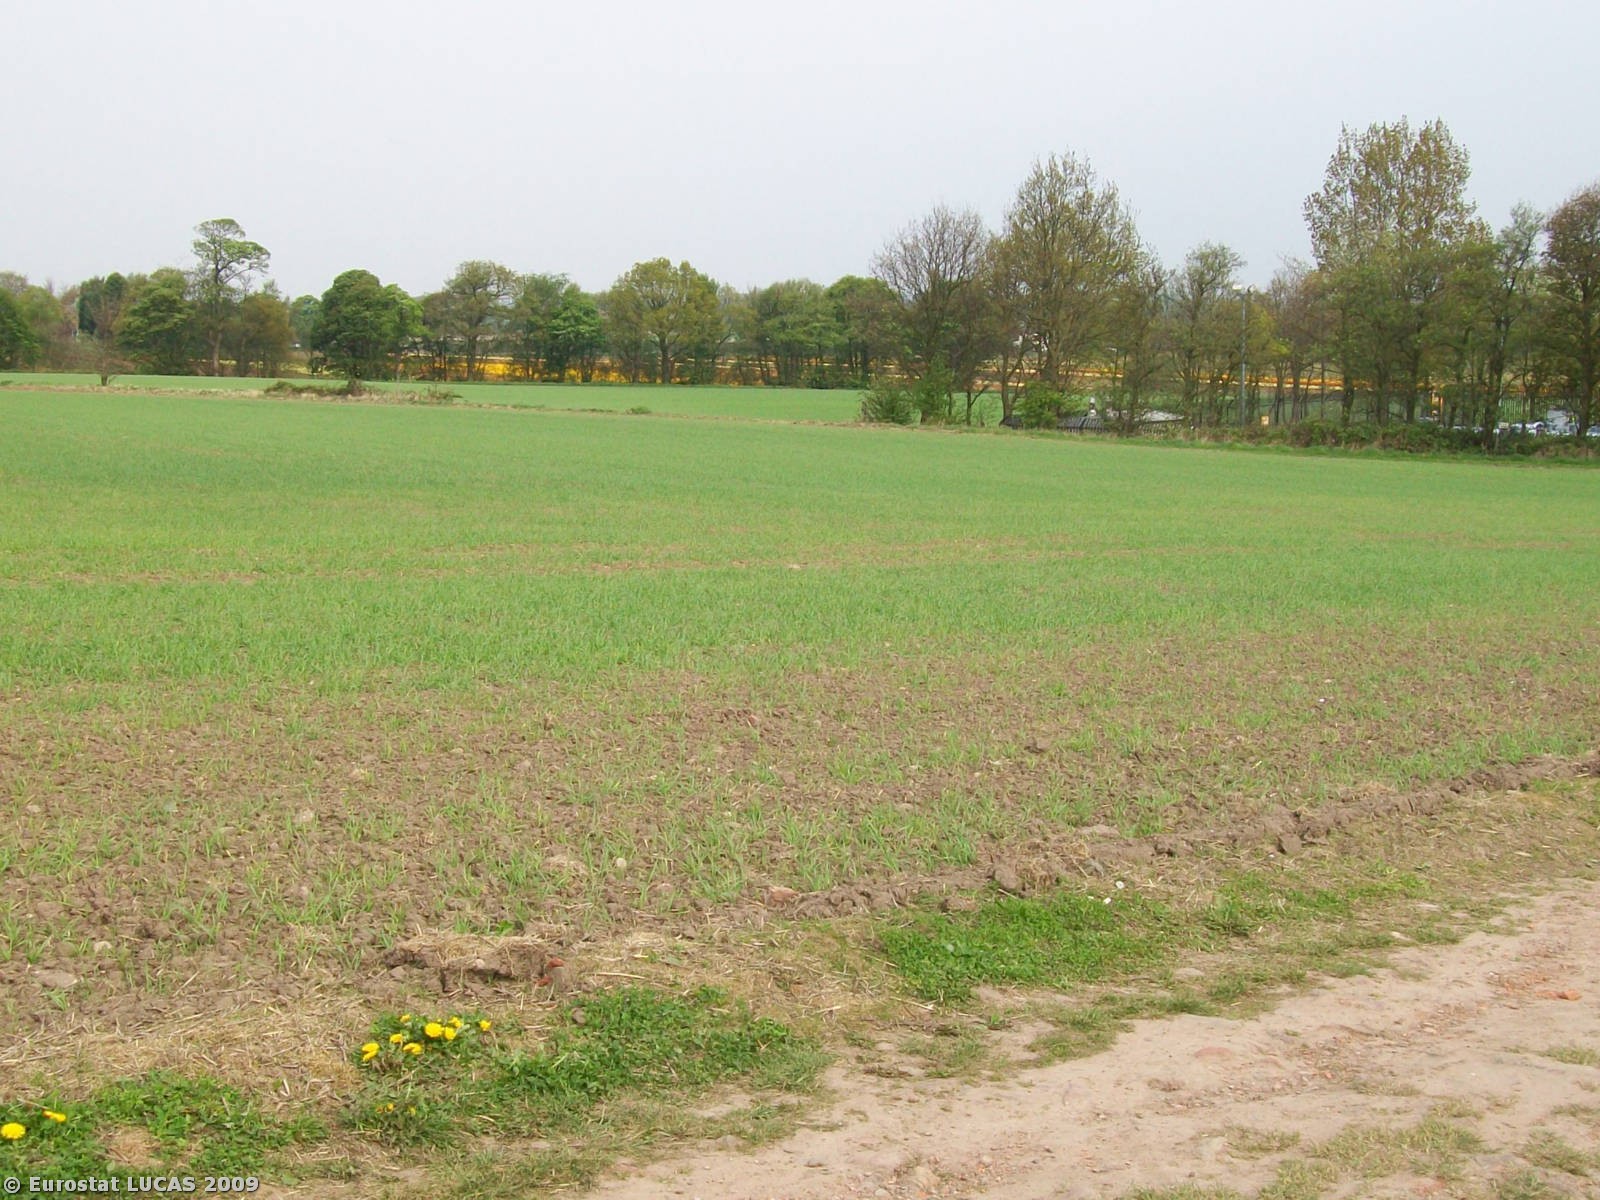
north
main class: Cropland
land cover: Barley
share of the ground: 50 - 75 %
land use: Agriculture (excluding fallow land and kitchen gardens)
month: April
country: GB
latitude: 53.5687
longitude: -2.8612
